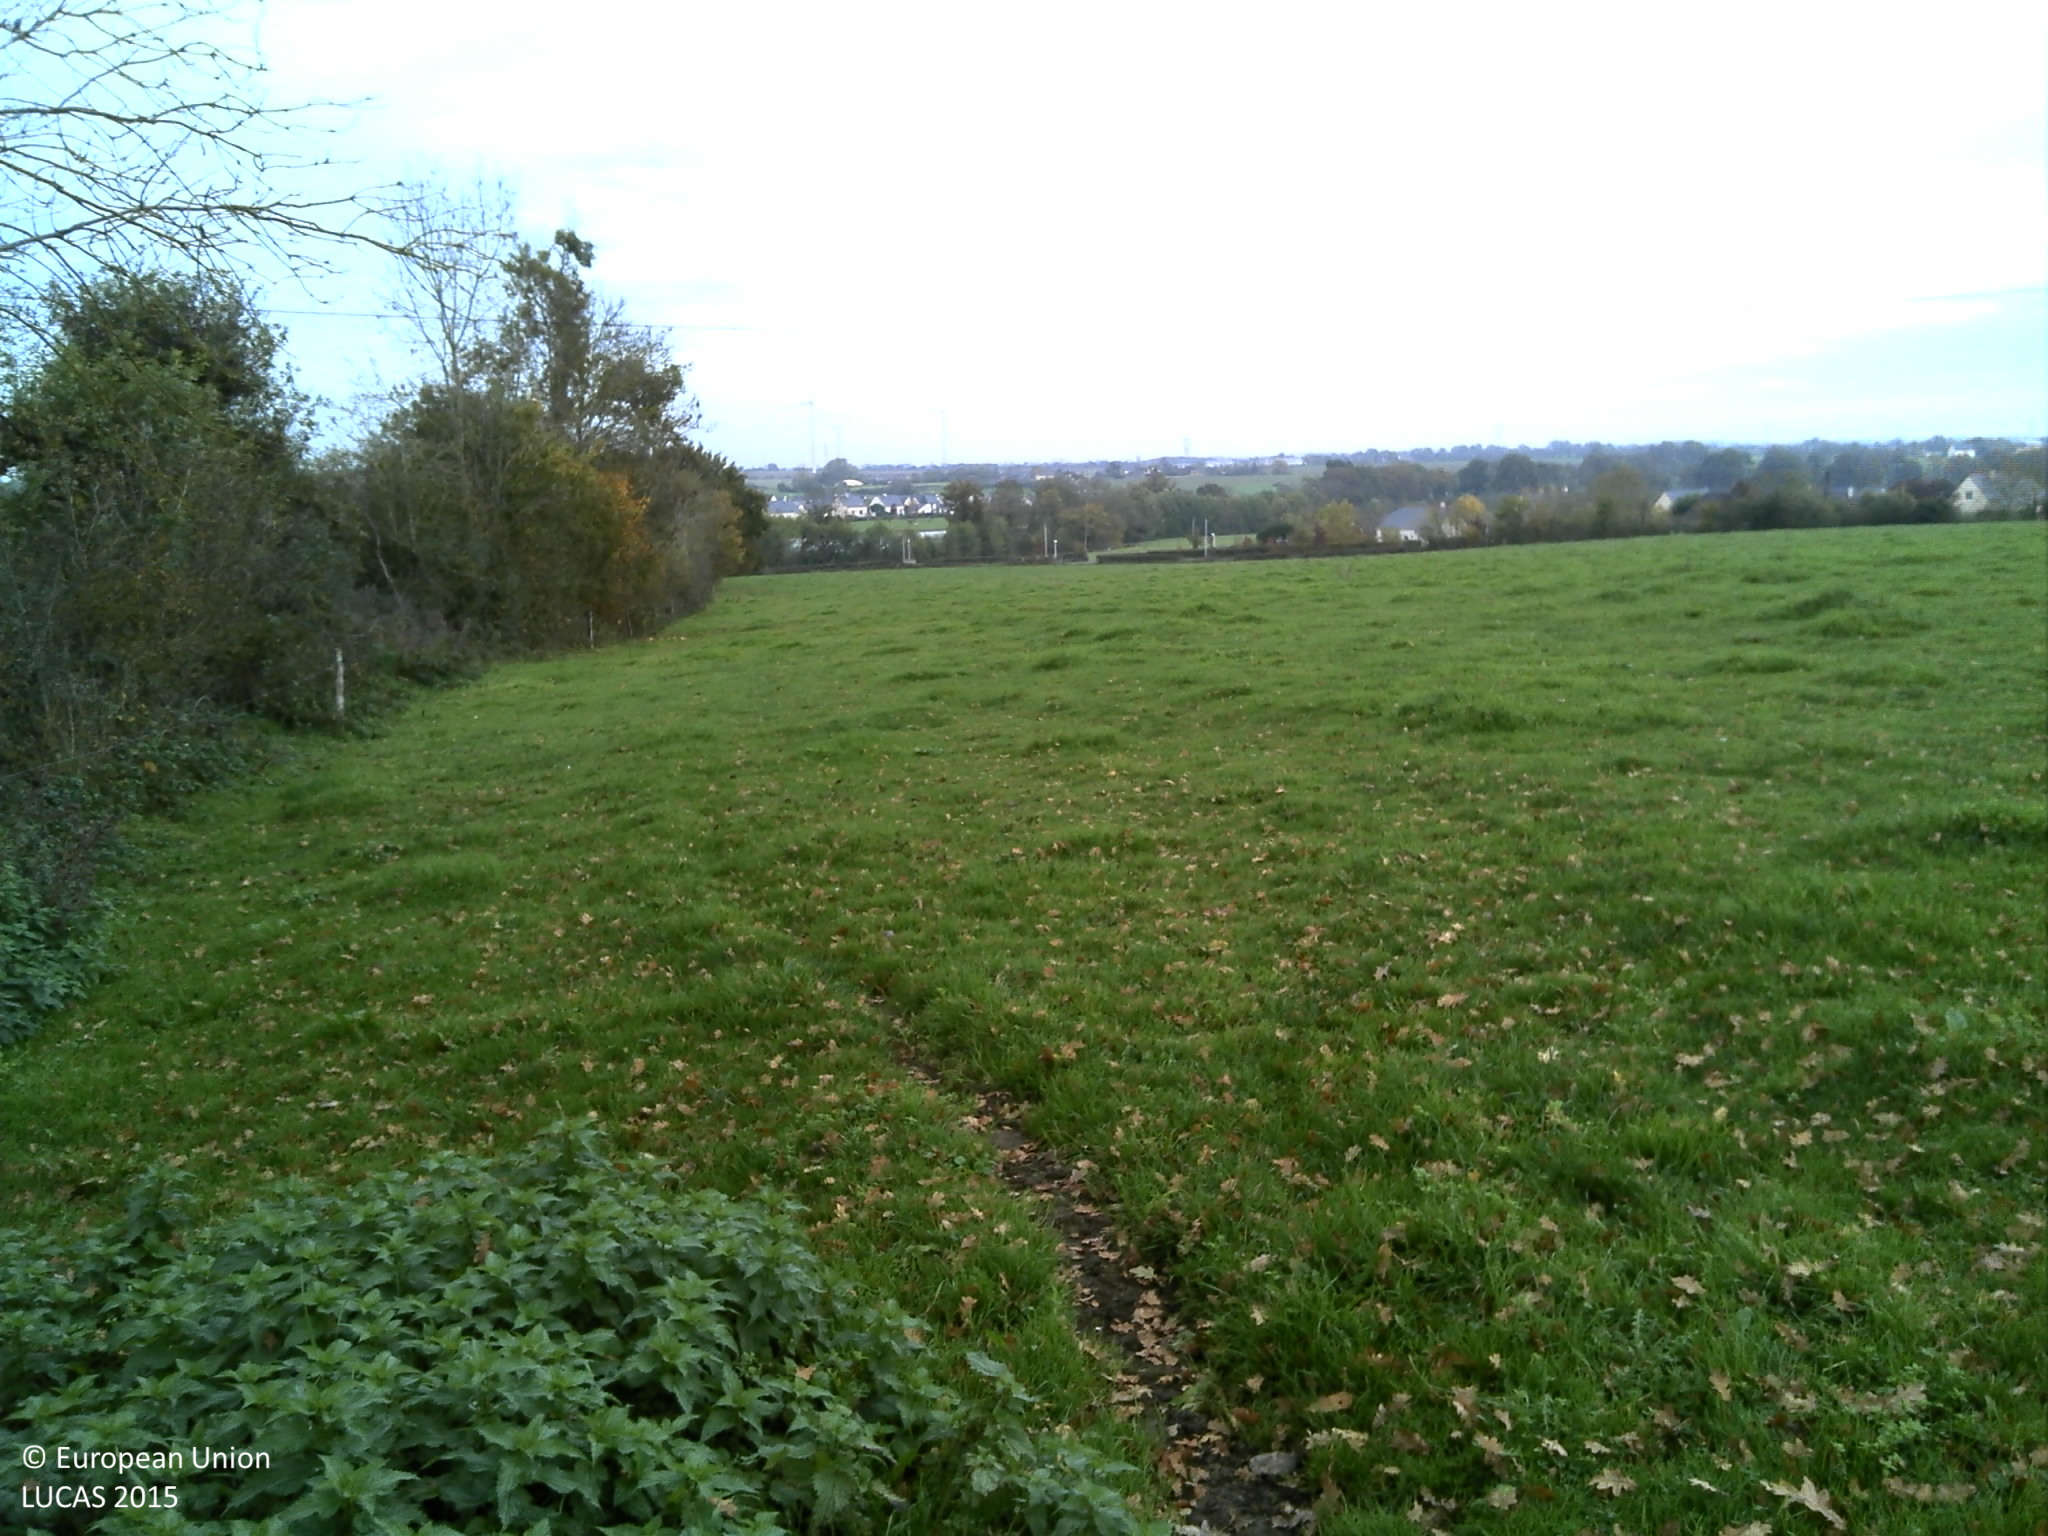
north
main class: Grassland
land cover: Grassland without tree/shrub cover
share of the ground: > 75 %
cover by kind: herbaceous plants 85 %, unconsolidated bare surface 15 %
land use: Agriculture (excluding fallow land and kitchen gardens)
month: November
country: FR
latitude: 47.3875
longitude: -1.2863
